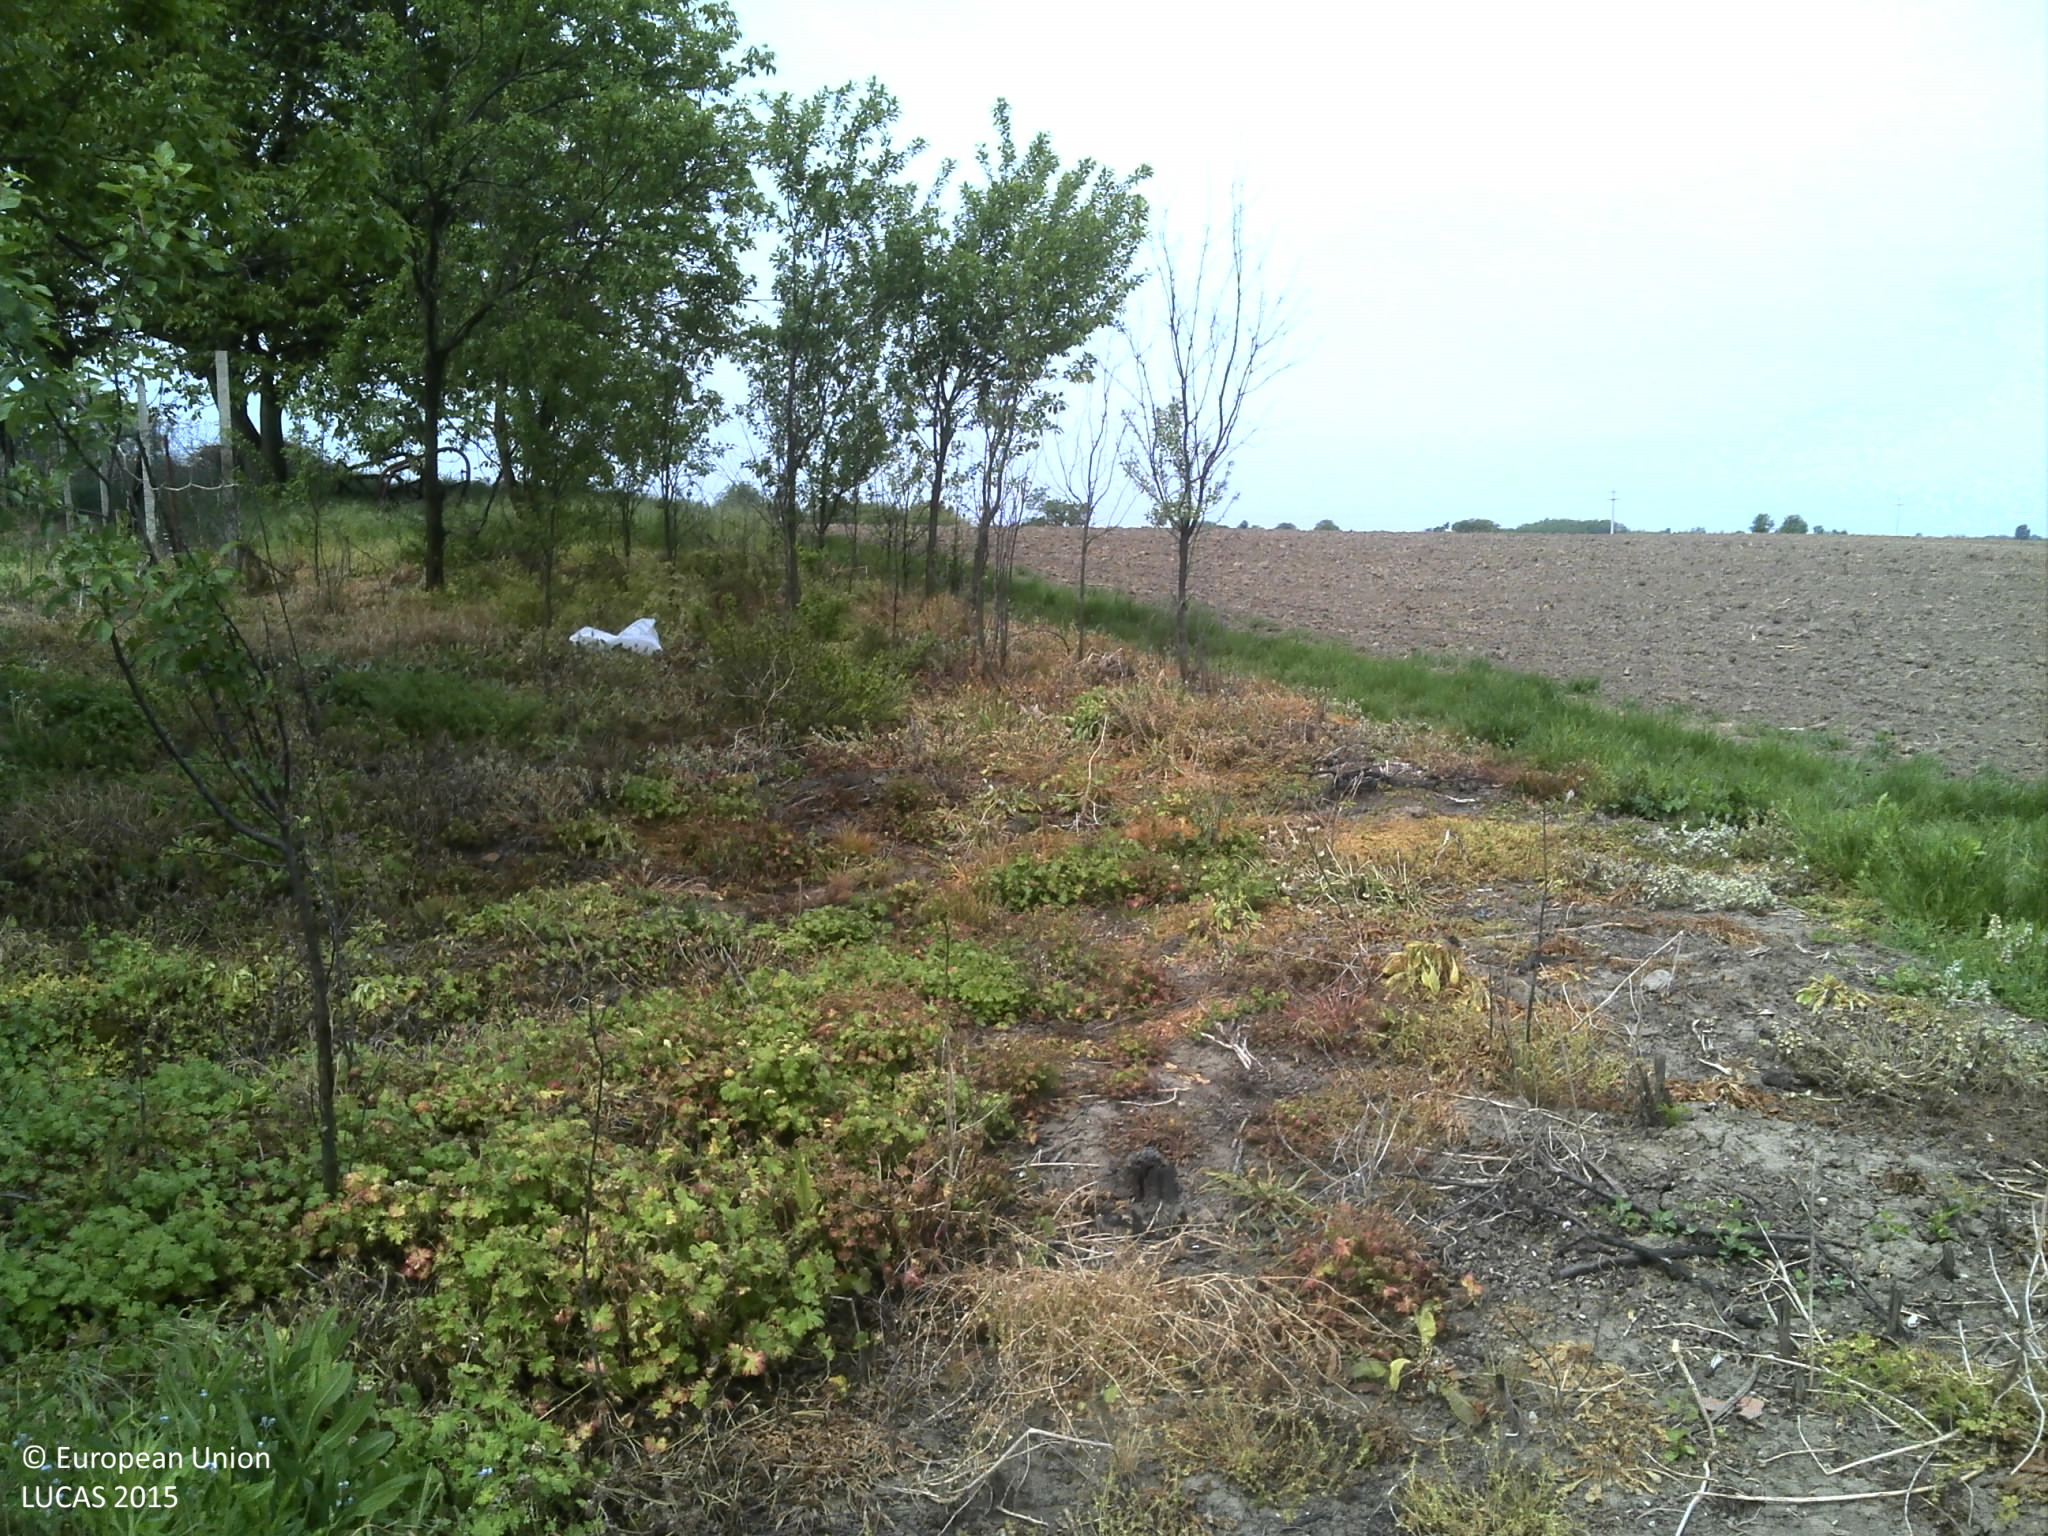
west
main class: Cropland
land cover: Other fruit trees and berries
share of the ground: > 75 %
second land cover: Spontaneously vegetated surfaces
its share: > 75 %
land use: Agriculture (excluding fallow land and kitchen gardens)
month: May
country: HR
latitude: 45.2383
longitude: 19.0916
